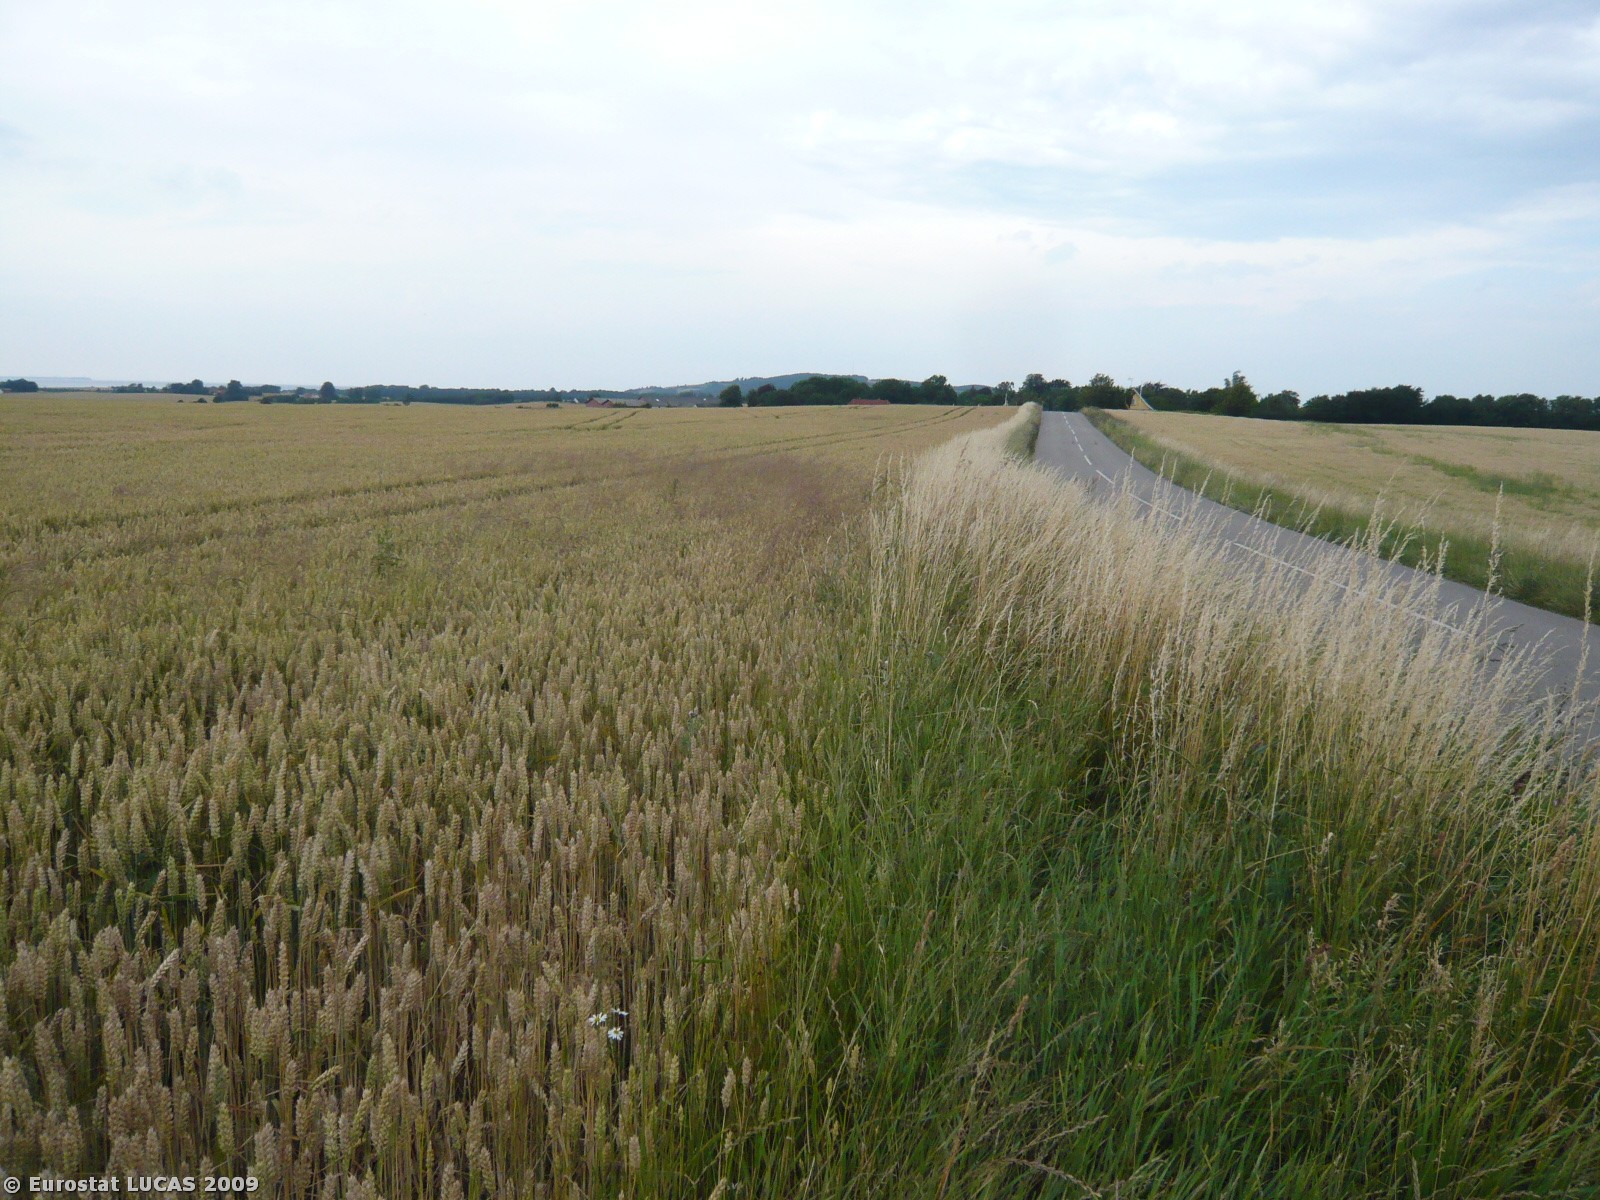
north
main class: Cropland
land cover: Common wheat
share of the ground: > 75 %
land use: Agriculture (excluding fallow land and kitchen gardens)
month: July
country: DK
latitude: 55.7485
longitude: 11.4165
